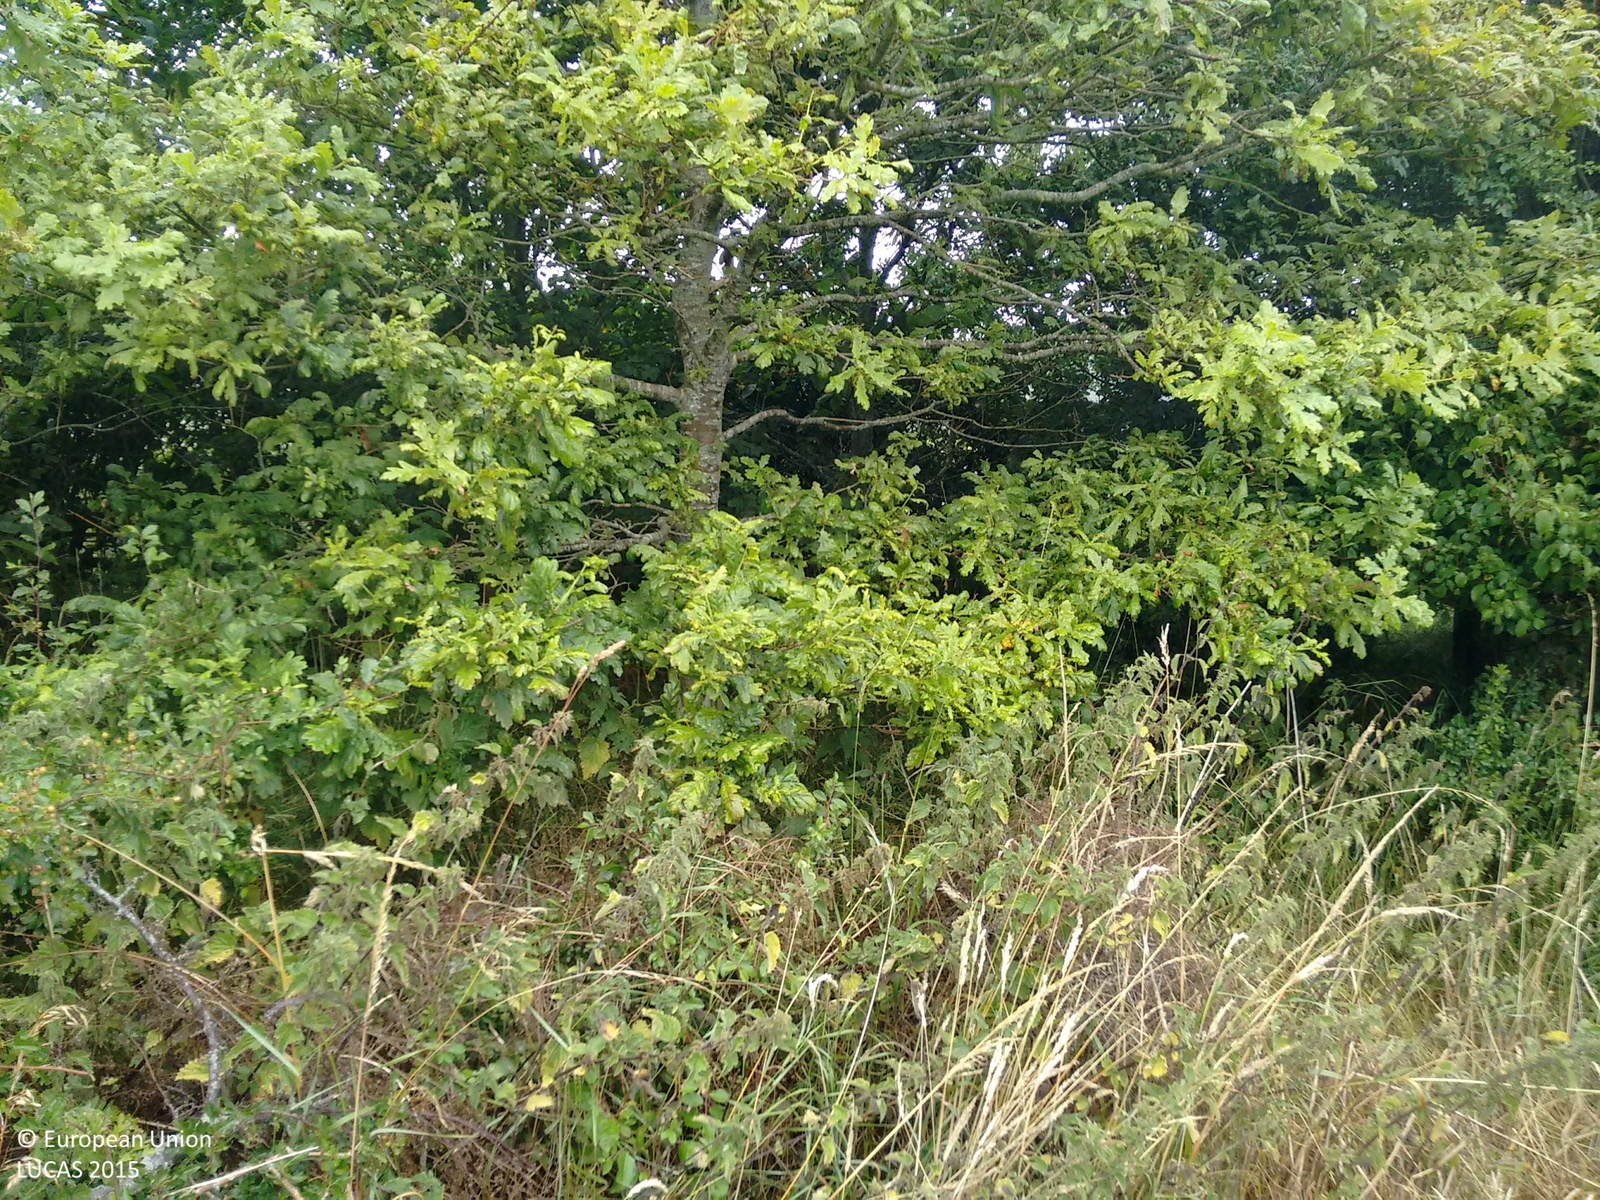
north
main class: Cropland
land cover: Maize
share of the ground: > 75 %
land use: Agriculture (excluding fallow land and kitchen gardens)
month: July
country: GB
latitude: 50.7115
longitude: -2.3418
